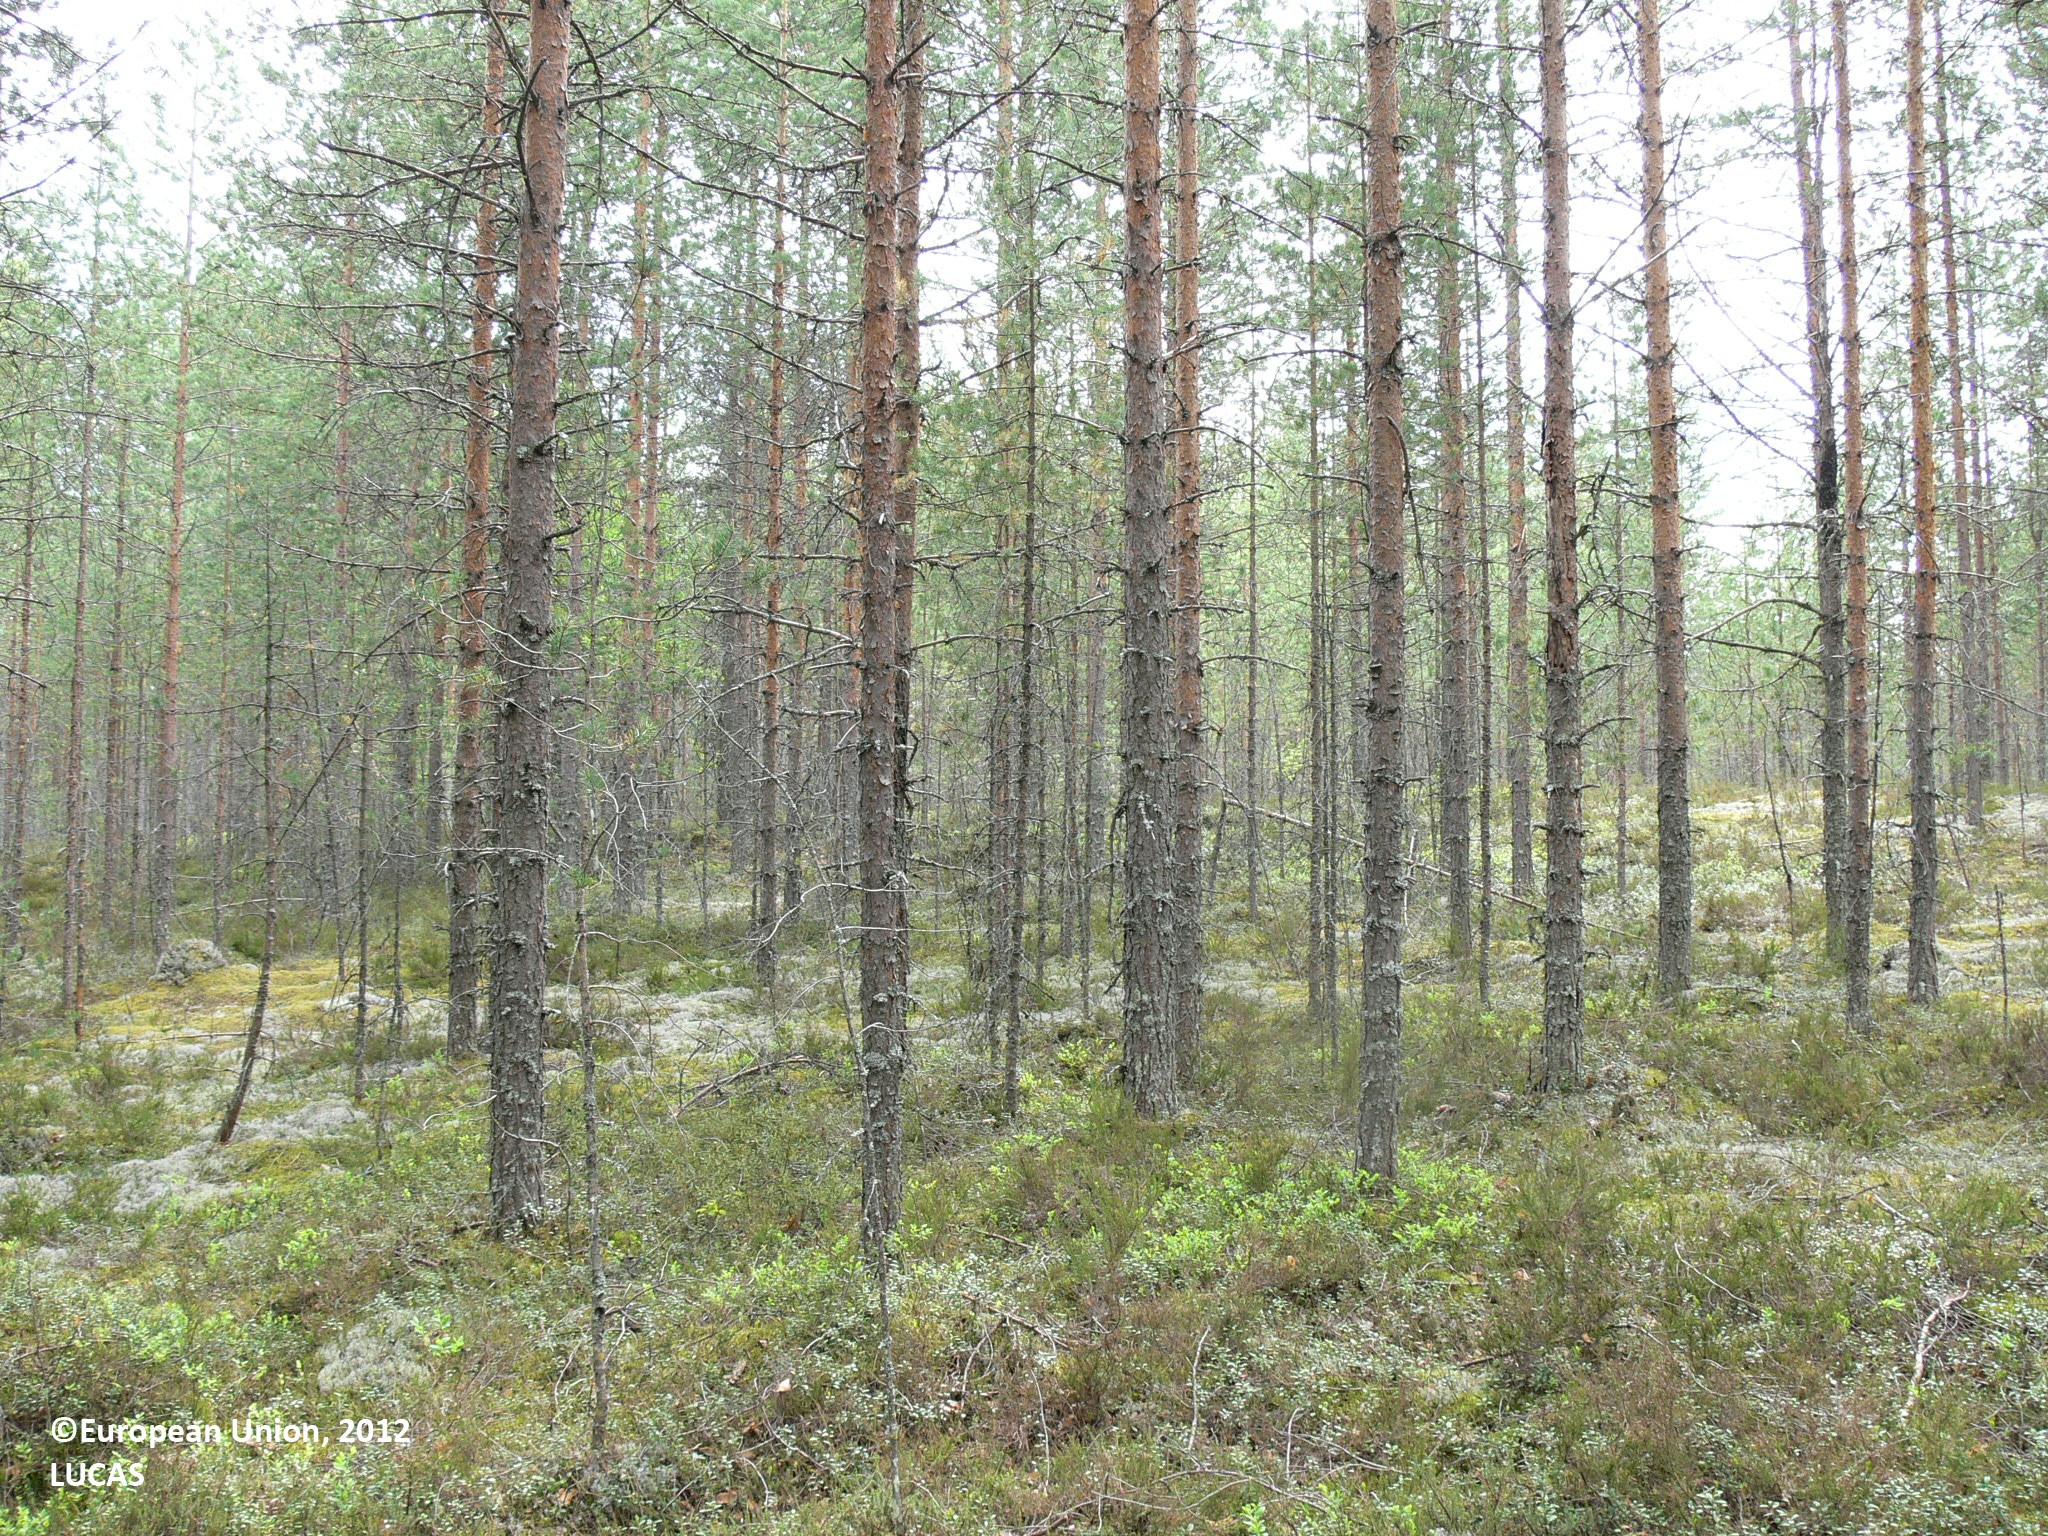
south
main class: Woodland
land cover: Pine dominated coniferous woodland
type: boreal forest
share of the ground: > 75 %
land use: Forestry
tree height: > 5 m
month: June
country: FI
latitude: 62.2713
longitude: 30.1716
